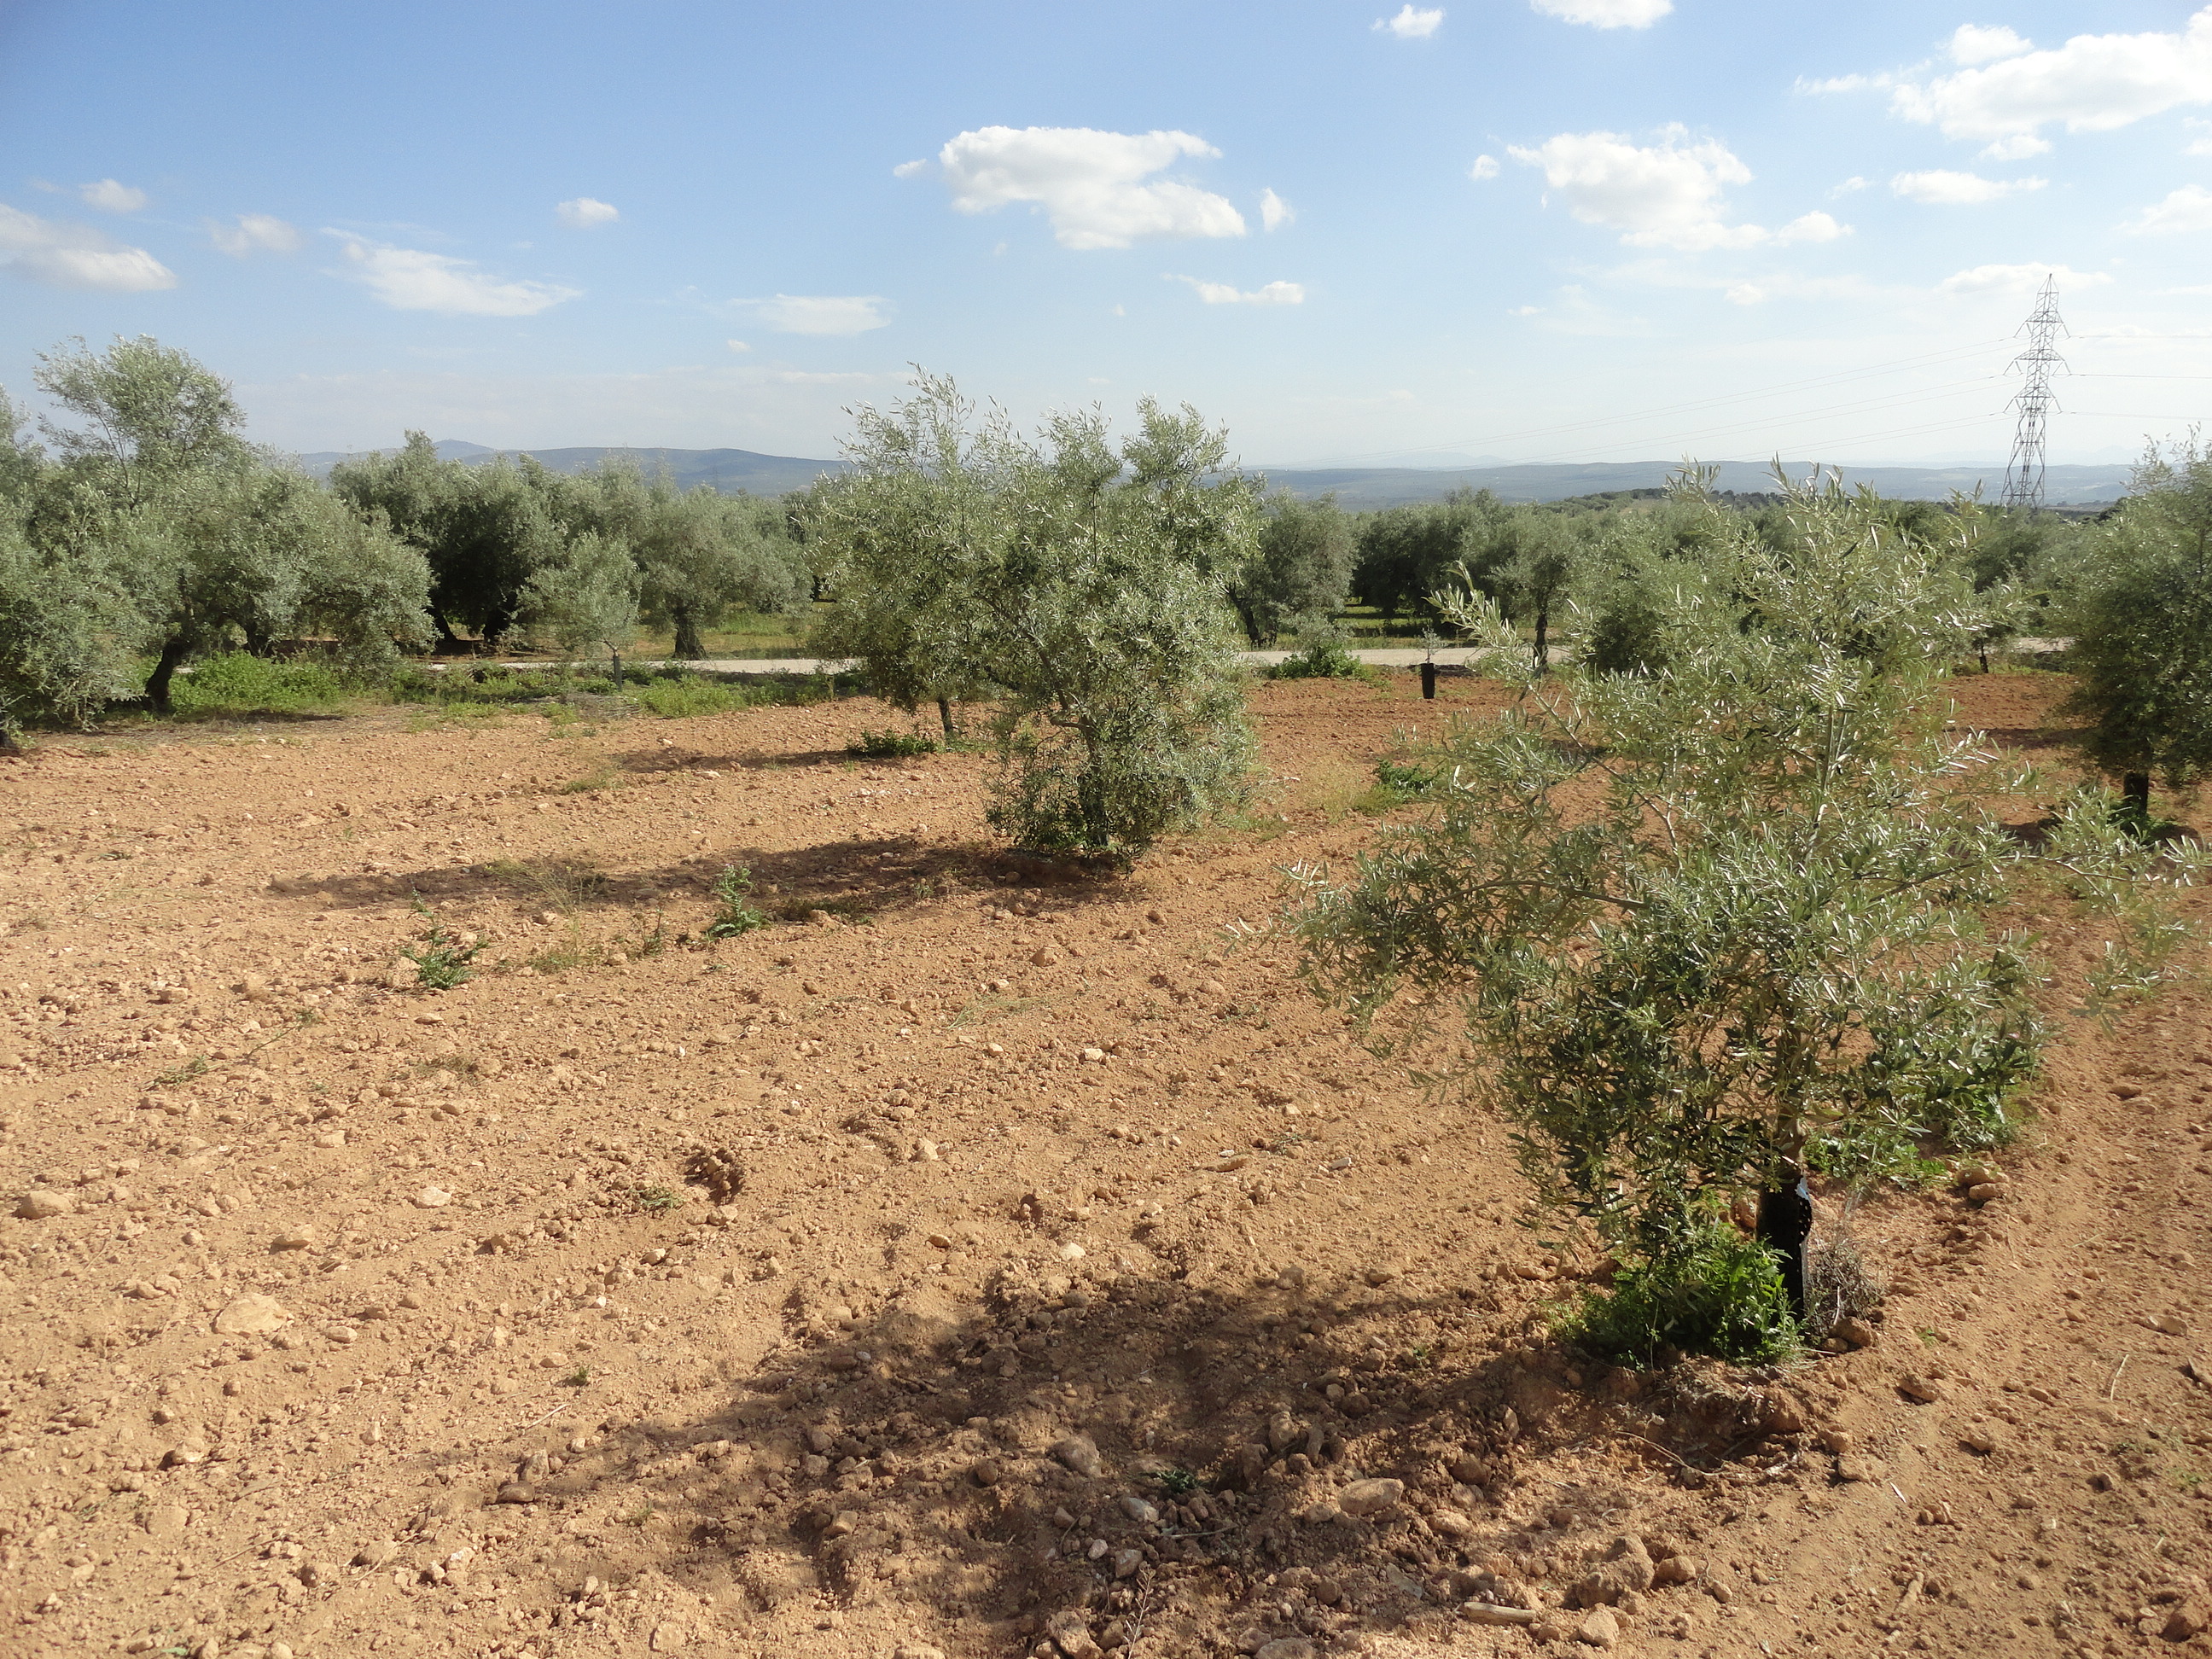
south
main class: Cropland
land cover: Olive groves
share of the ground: 10 - 25 %
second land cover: Other bare soil
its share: > 75 %
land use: Agriculture (excluding fallow land and kitchen gardens)
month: April
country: ES
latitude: 37.5272
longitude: -4.5230
